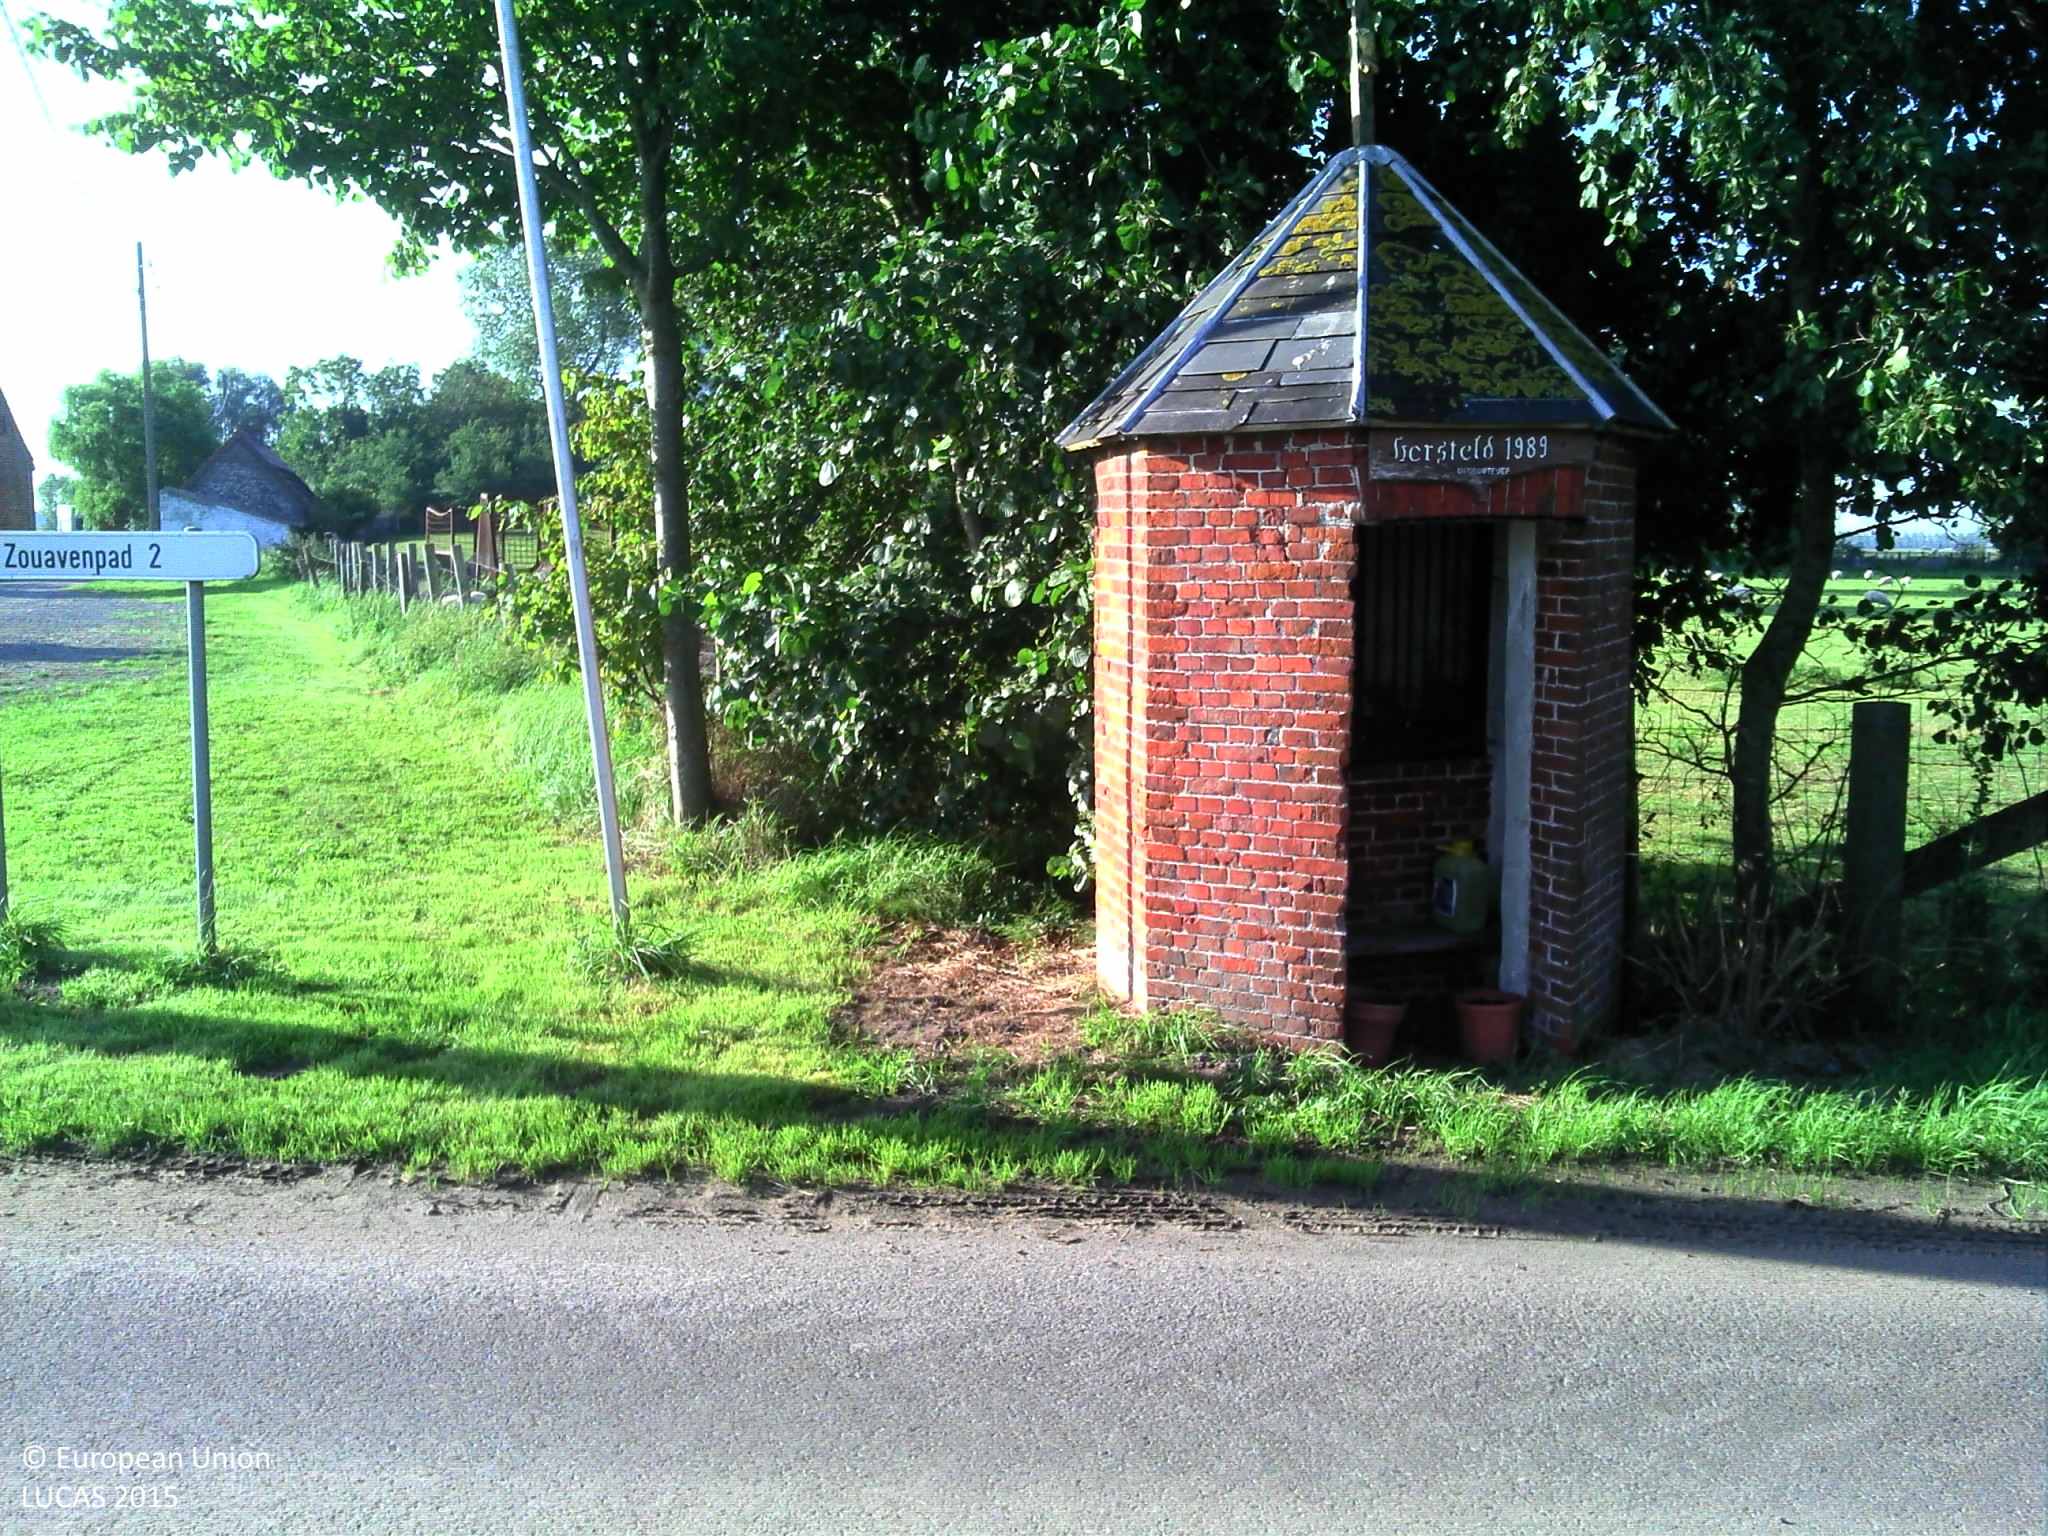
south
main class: Grassland
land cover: Grassland without tree/shrub cover
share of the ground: > 75 %
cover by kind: herbaceous plants 100 %
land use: Agriculture (excluding fallow land and kitchen gardens)
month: September
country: BE
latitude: 51.1247
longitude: 2.7157
